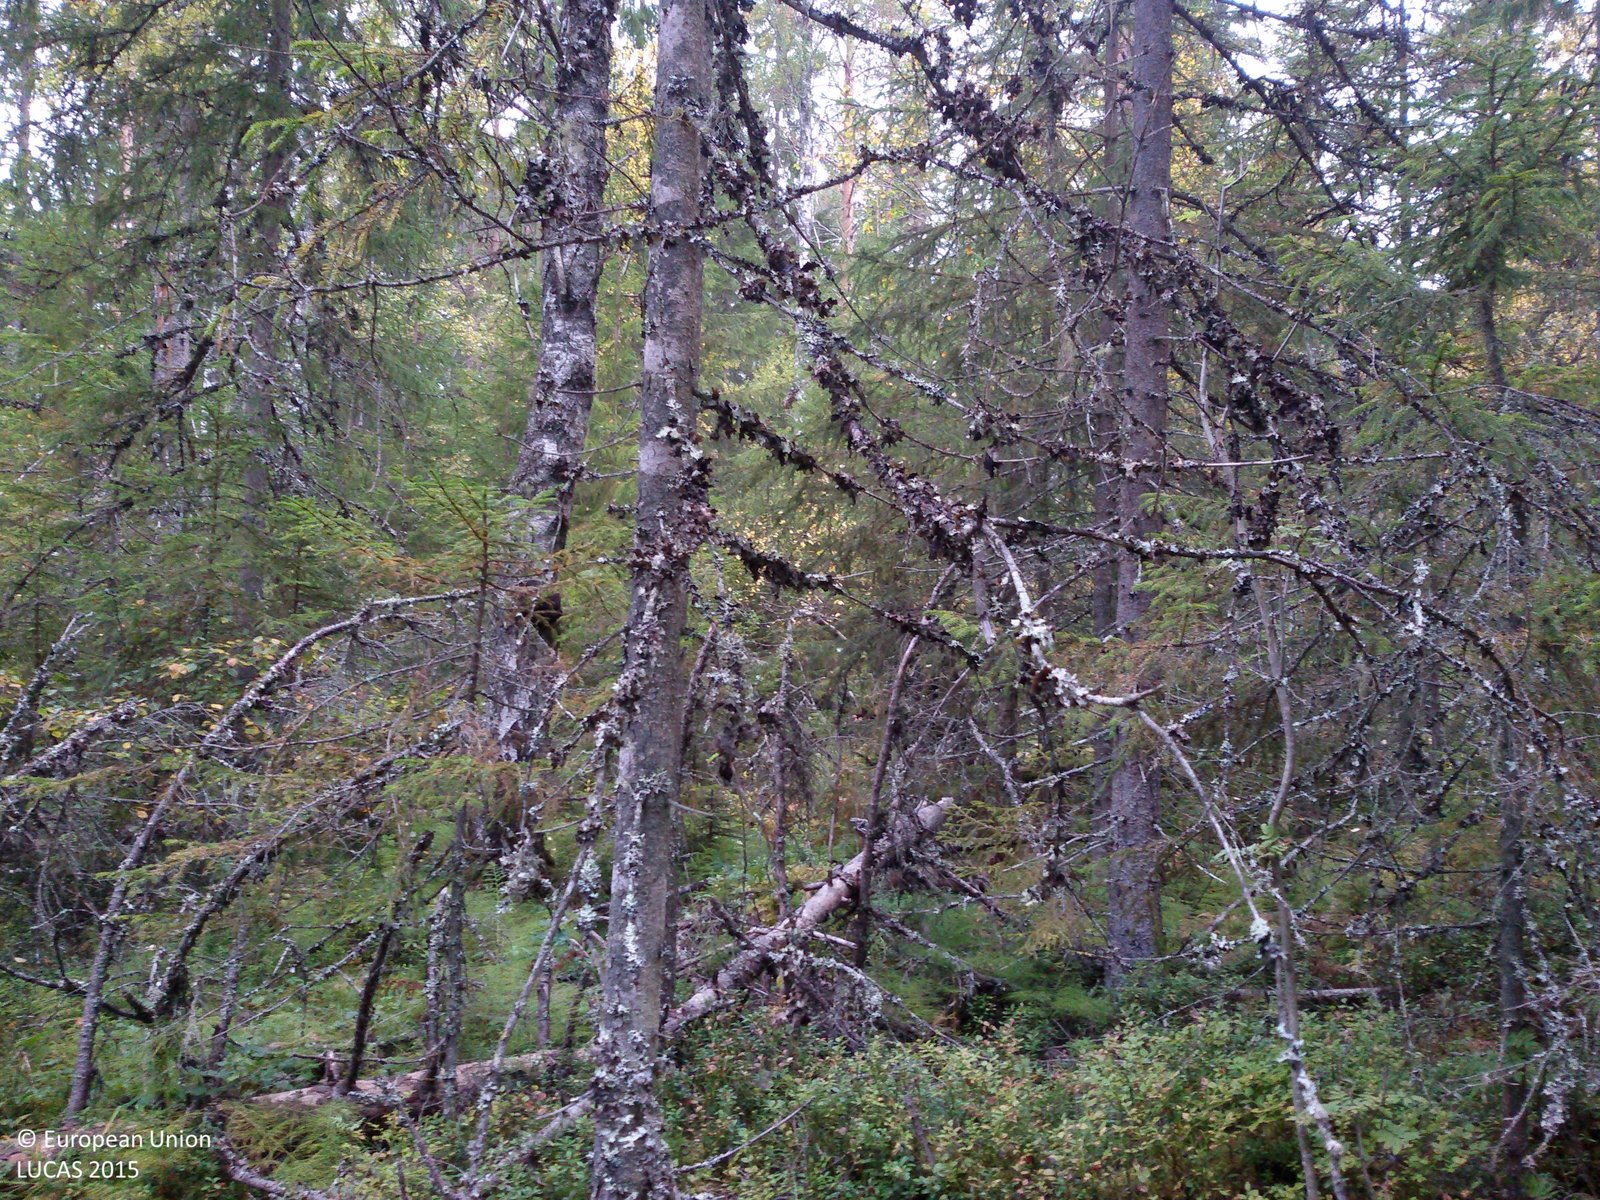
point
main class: Woodland
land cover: Spruce dominated mixed woodland
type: boreal forest
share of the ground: 50 - 75 %
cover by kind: coniferous forest trees 45 %, broadleaved forest trees 25 %, herbaceous plants 15 %, lichens and mosses 15 %
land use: Forestry
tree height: > 5 m
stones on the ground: 10 - 25 %
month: September
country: SE
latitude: 61.0518
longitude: 14.3392
